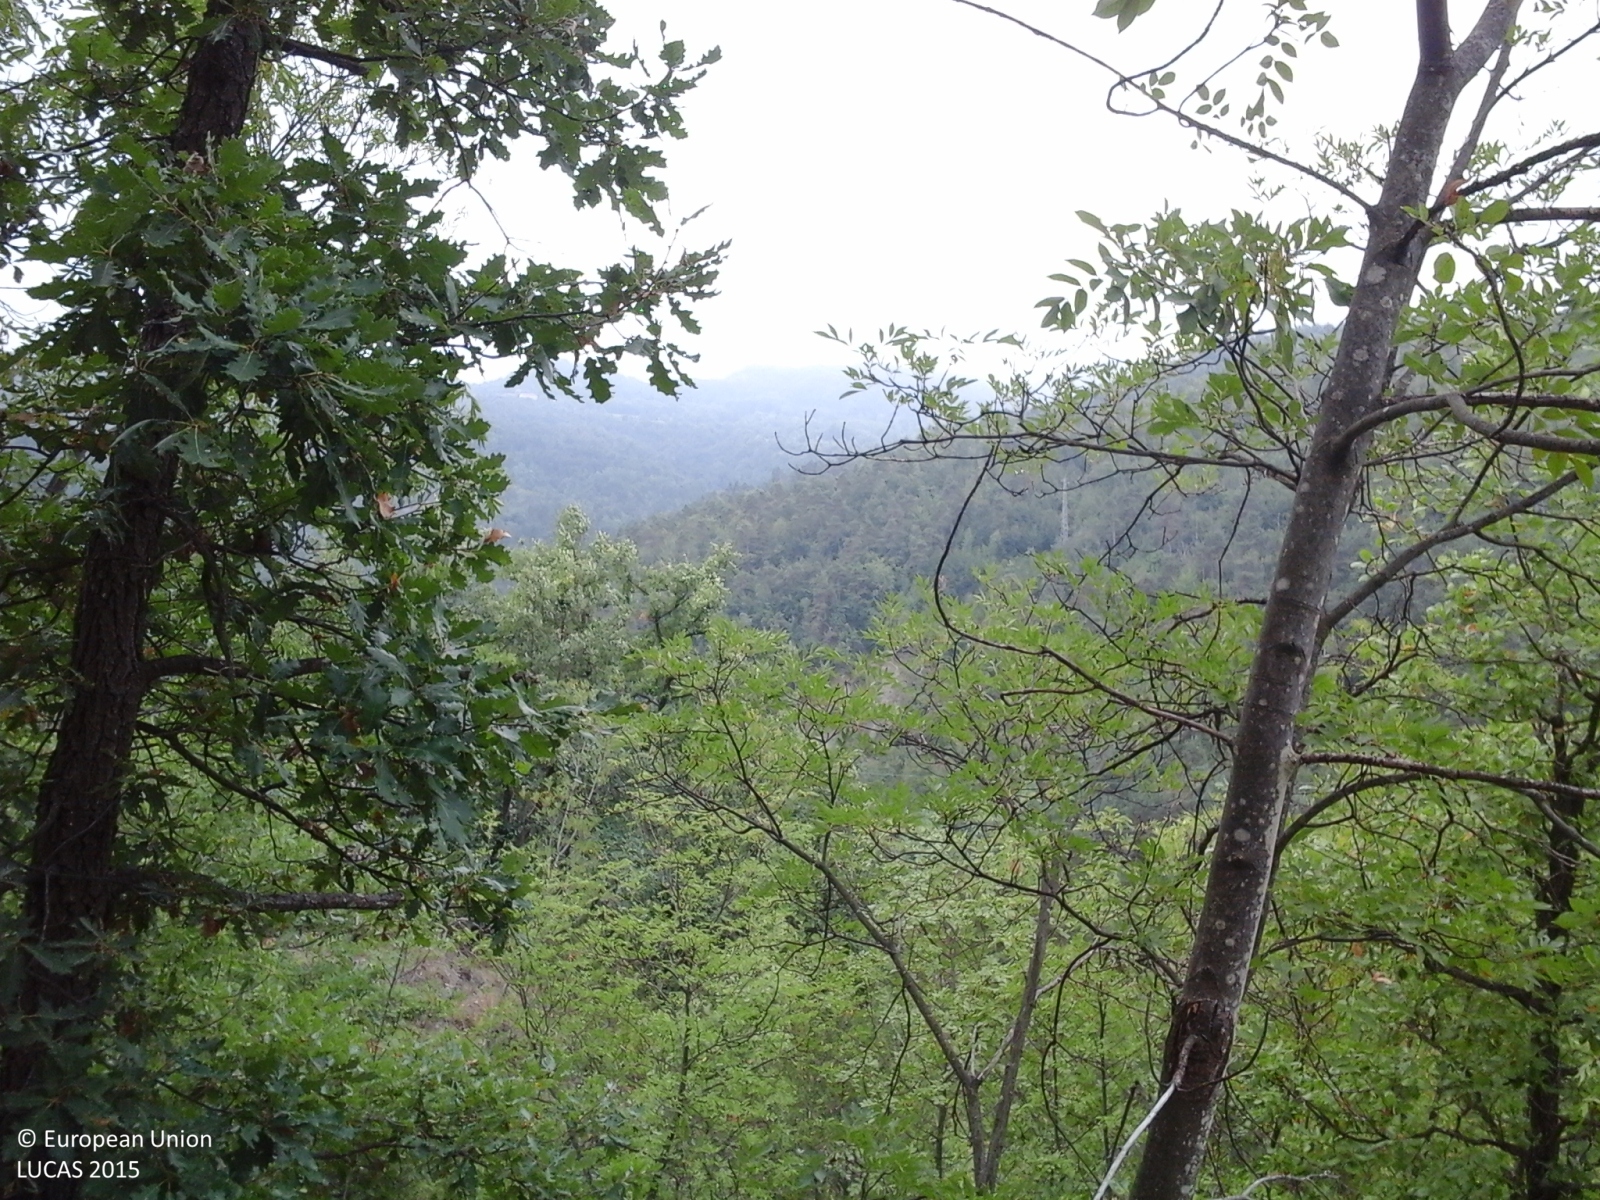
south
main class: Woodland
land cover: Broadleaved woodland
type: mesophytic deciduous forest
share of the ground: > 75 %
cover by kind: broadleaved forest trees 80 %, shrubs 10 %, herbaceous plants 10 %
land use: Forestry
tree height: > 5 m
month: July
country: IT
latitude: 44.4982
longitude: 8.2556
